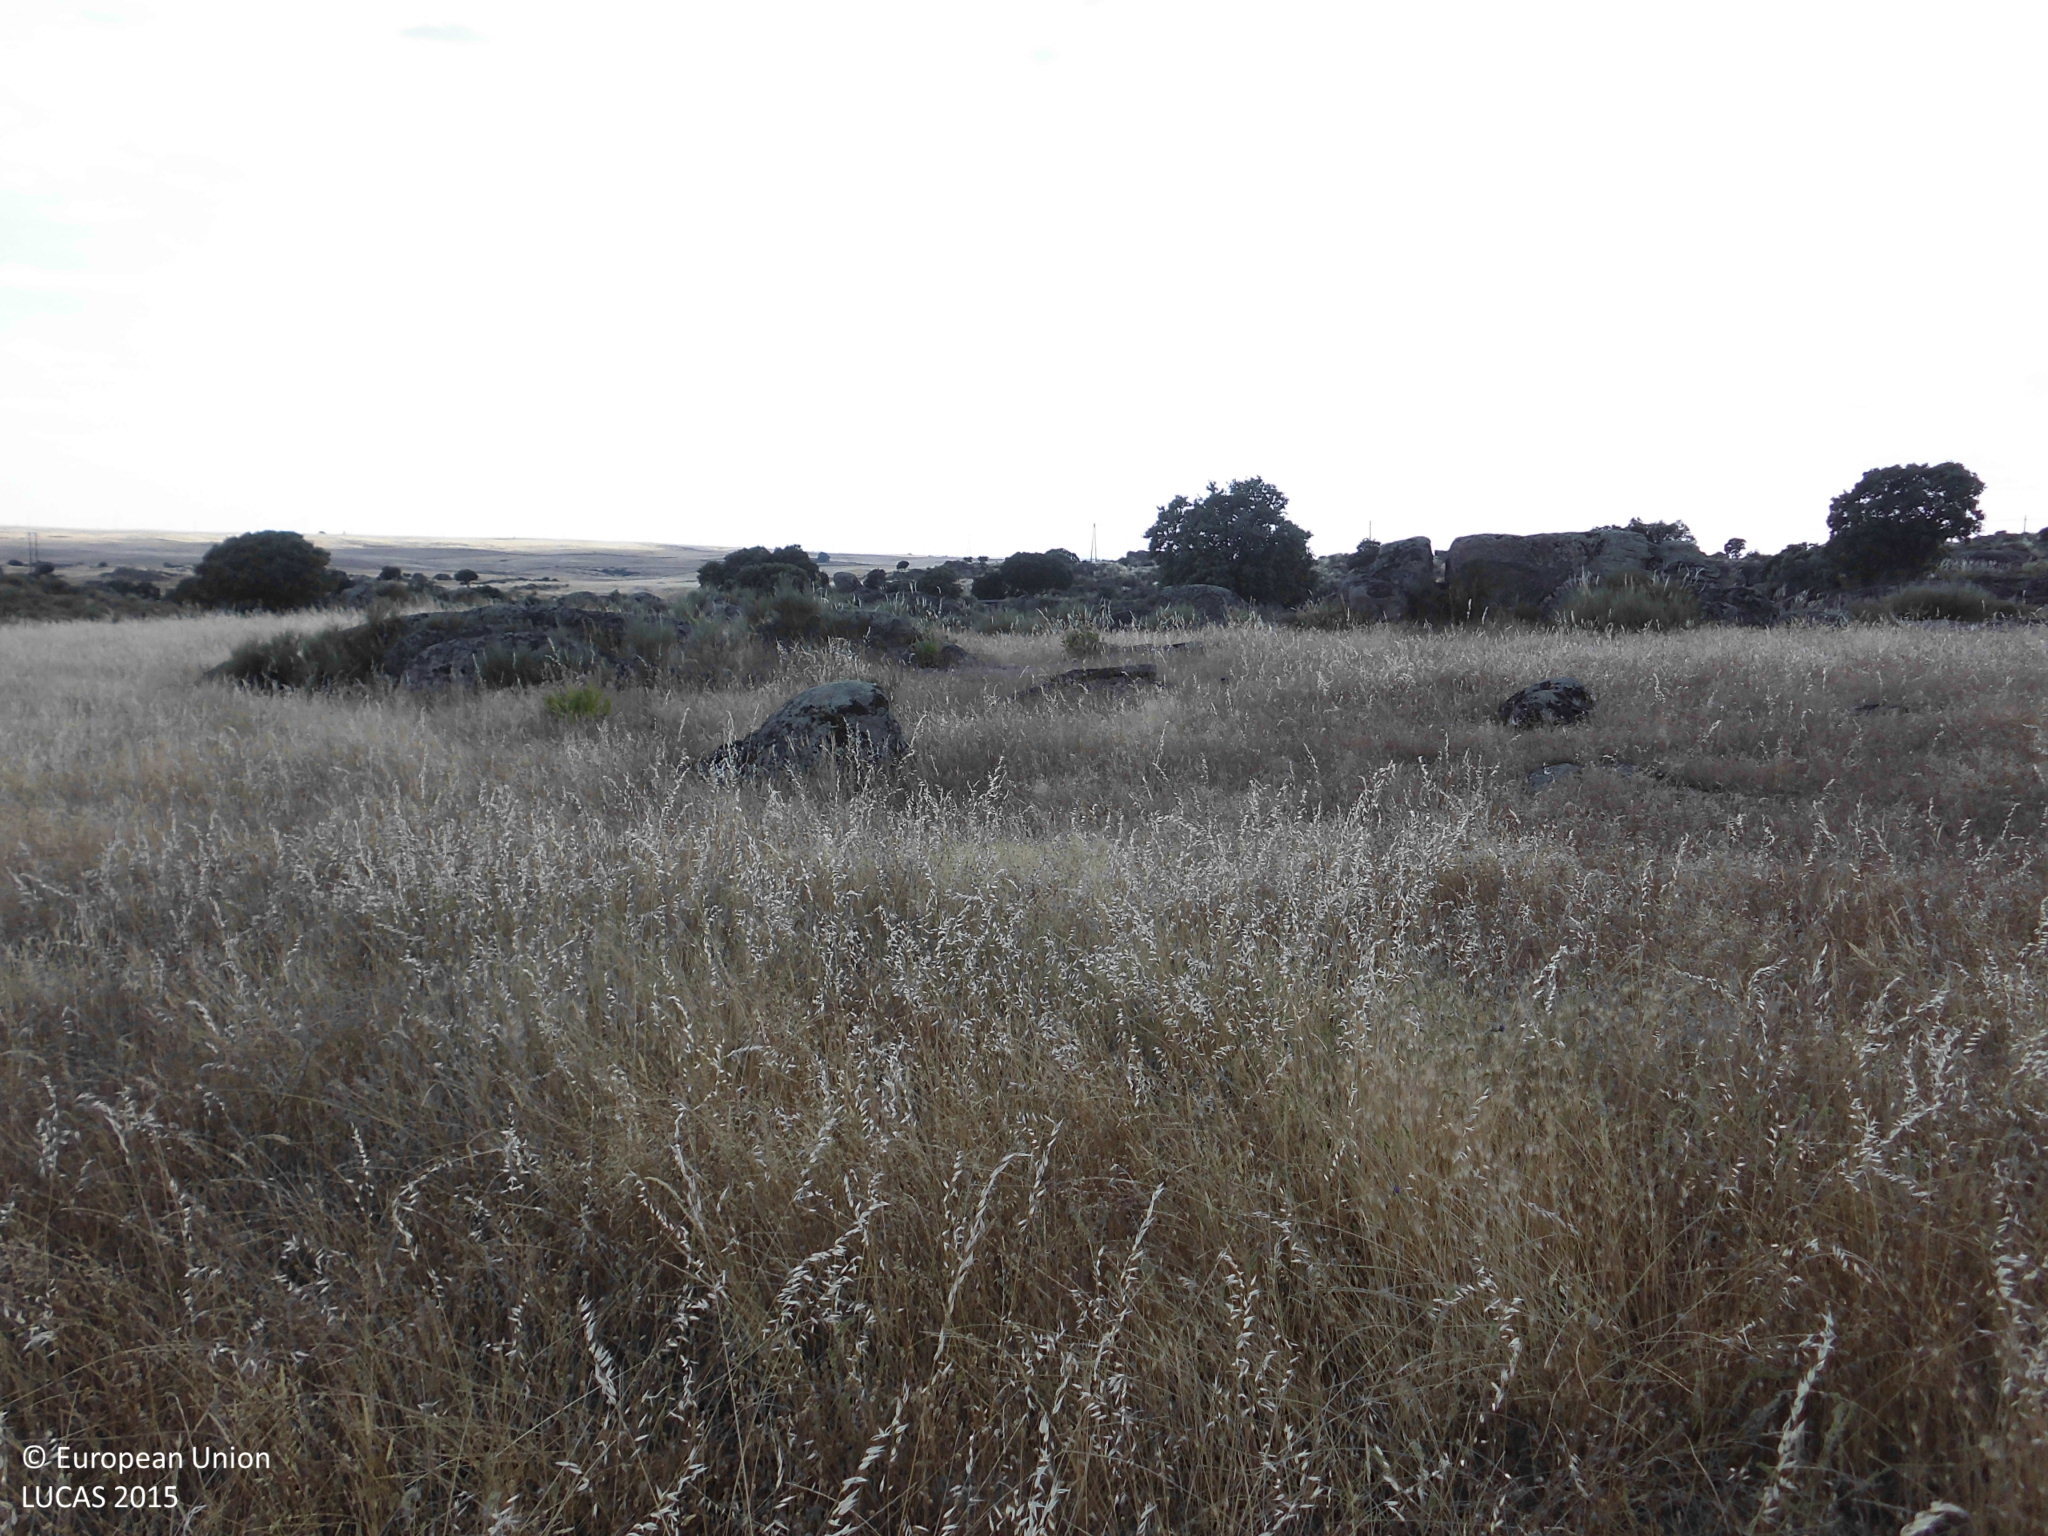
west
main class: Grassland
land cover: Grassland without tree/shrub cover
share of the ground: > 75 %
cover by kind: herbaceous plants 95 %, shrubs 5 %
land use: Agriculture (excluding fallow land and kitchen gardens)
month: June
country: ES
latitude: 39.4229
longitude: -5.8905
